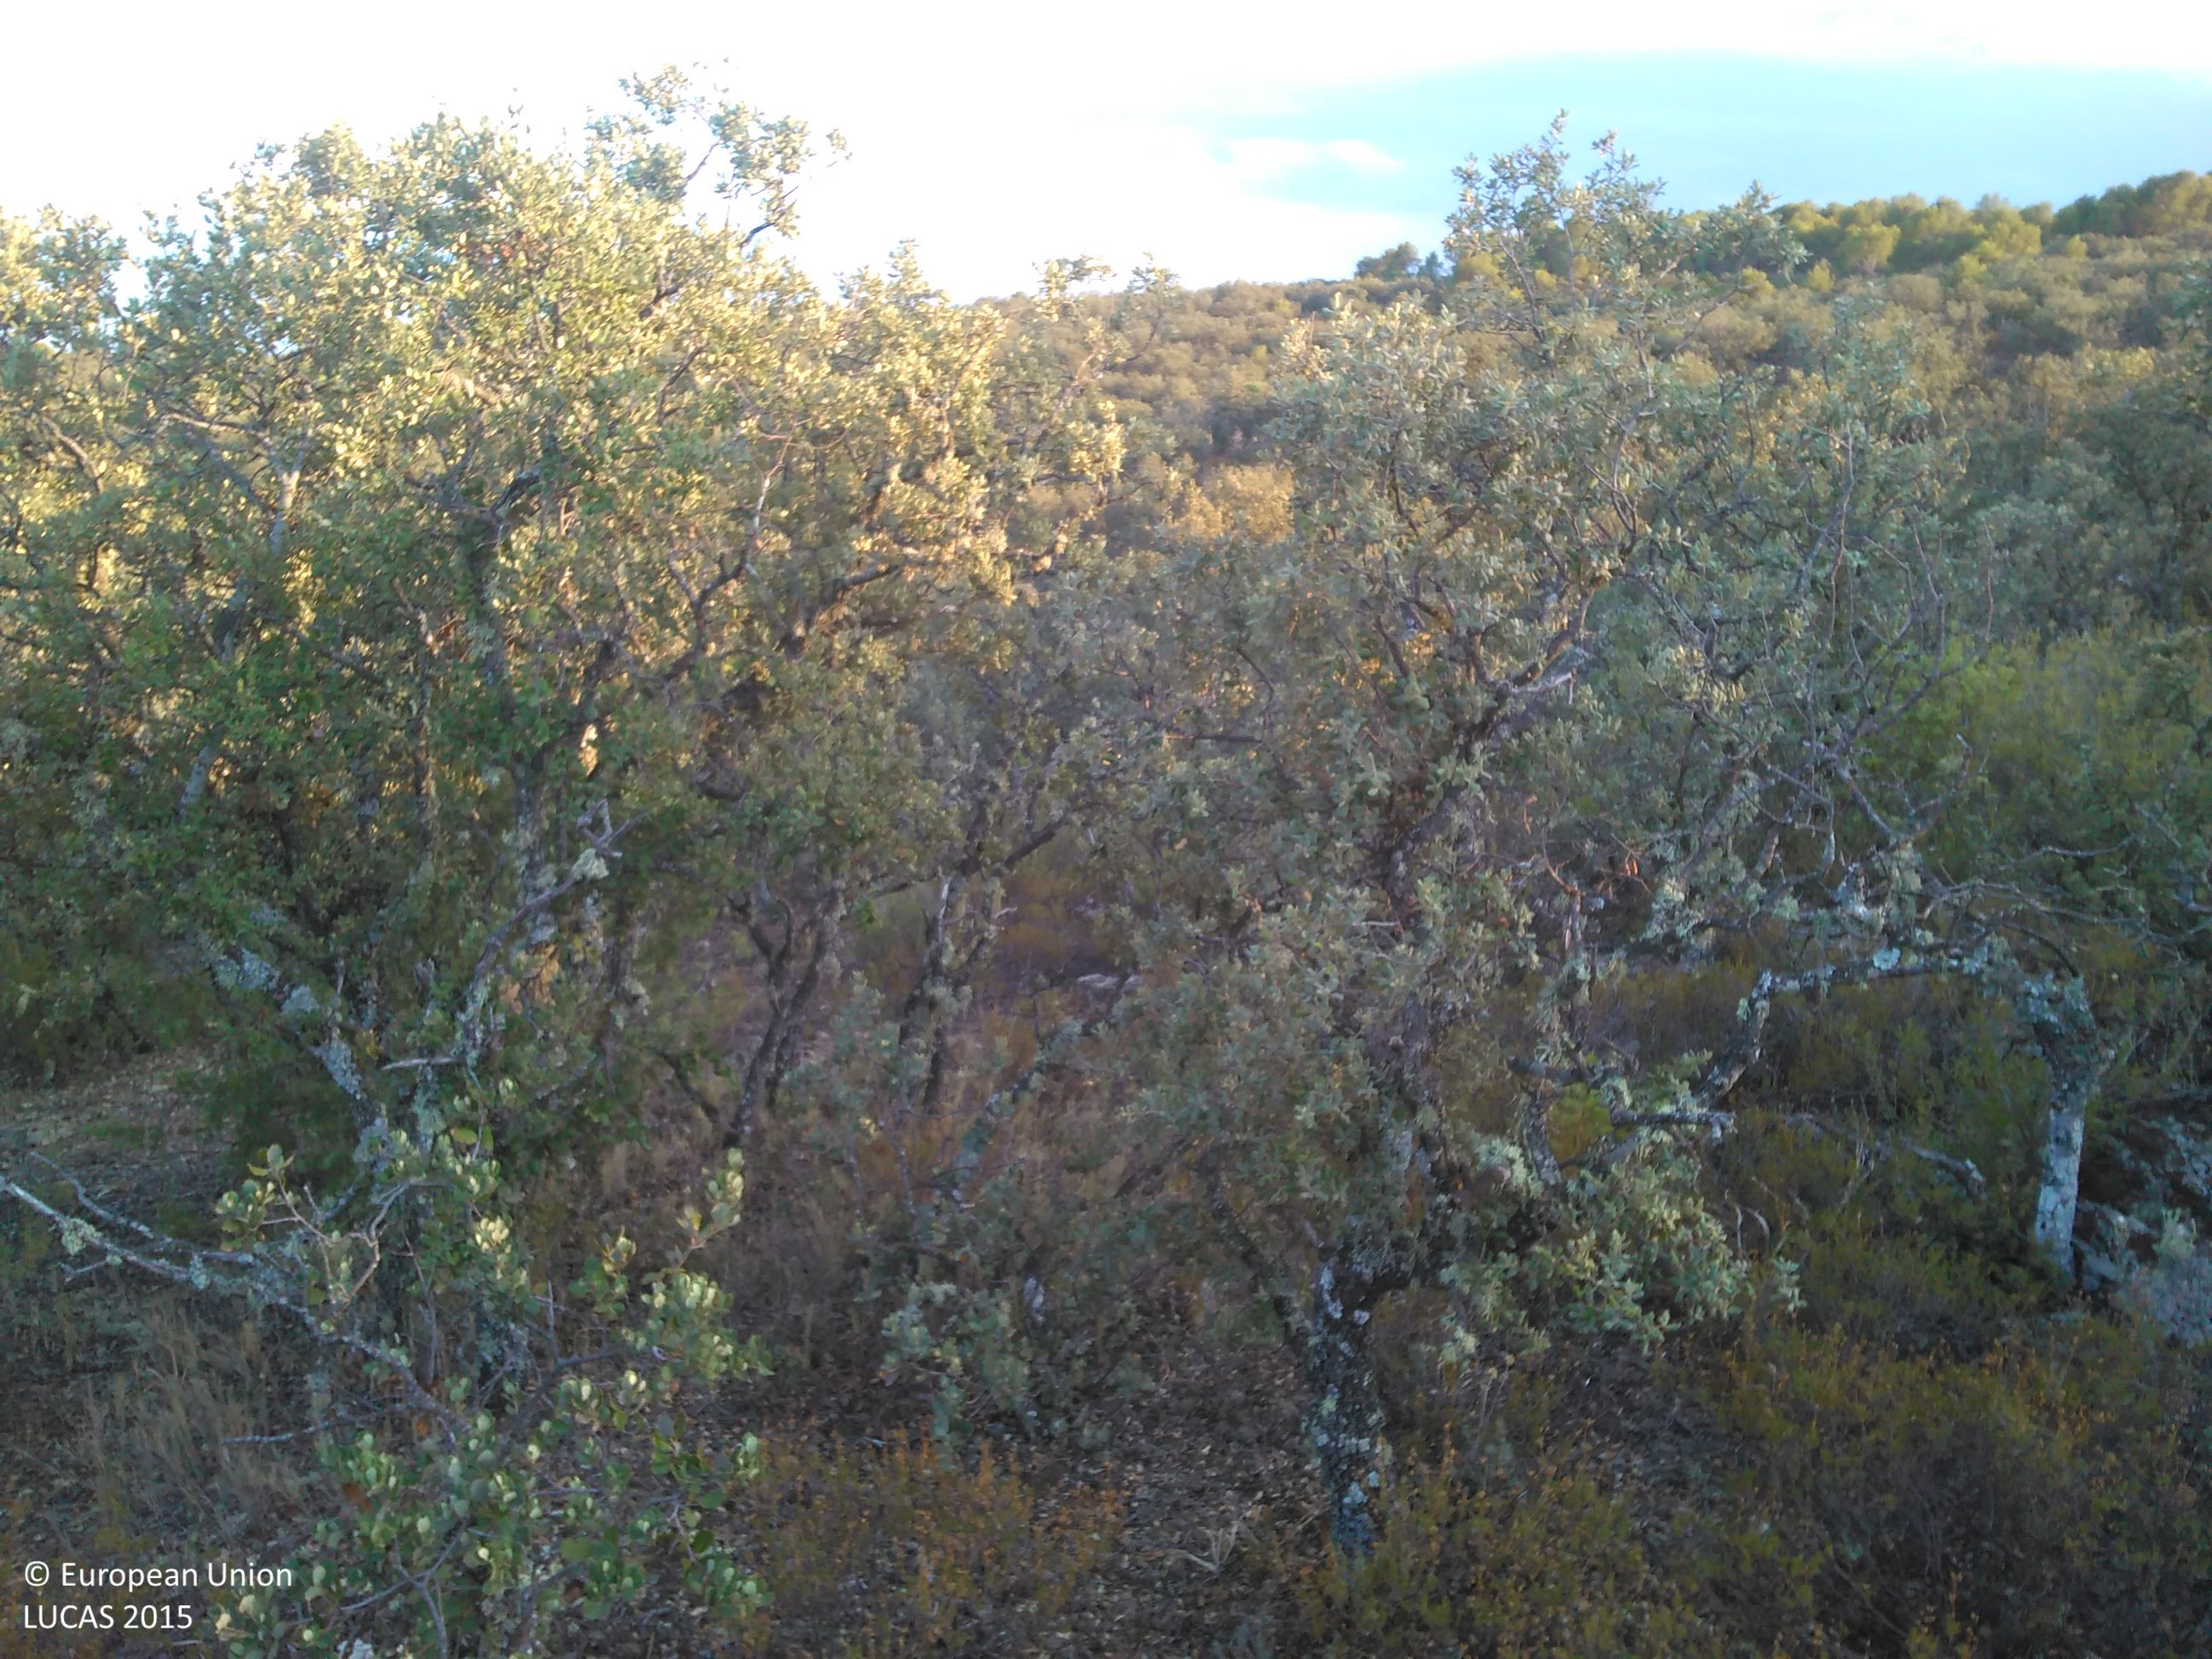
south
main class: Woodland
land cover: Broadleaved woodland
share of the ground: 50 - 75 %
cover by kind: broadleaved forest trees 50 %, shrubs 30 %, unconsolidated bare surface 20 %
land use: Semi-natural and natural areas not in use
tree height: < 5 m
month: July
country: ES
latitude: 41.4226
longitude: -1.8858
